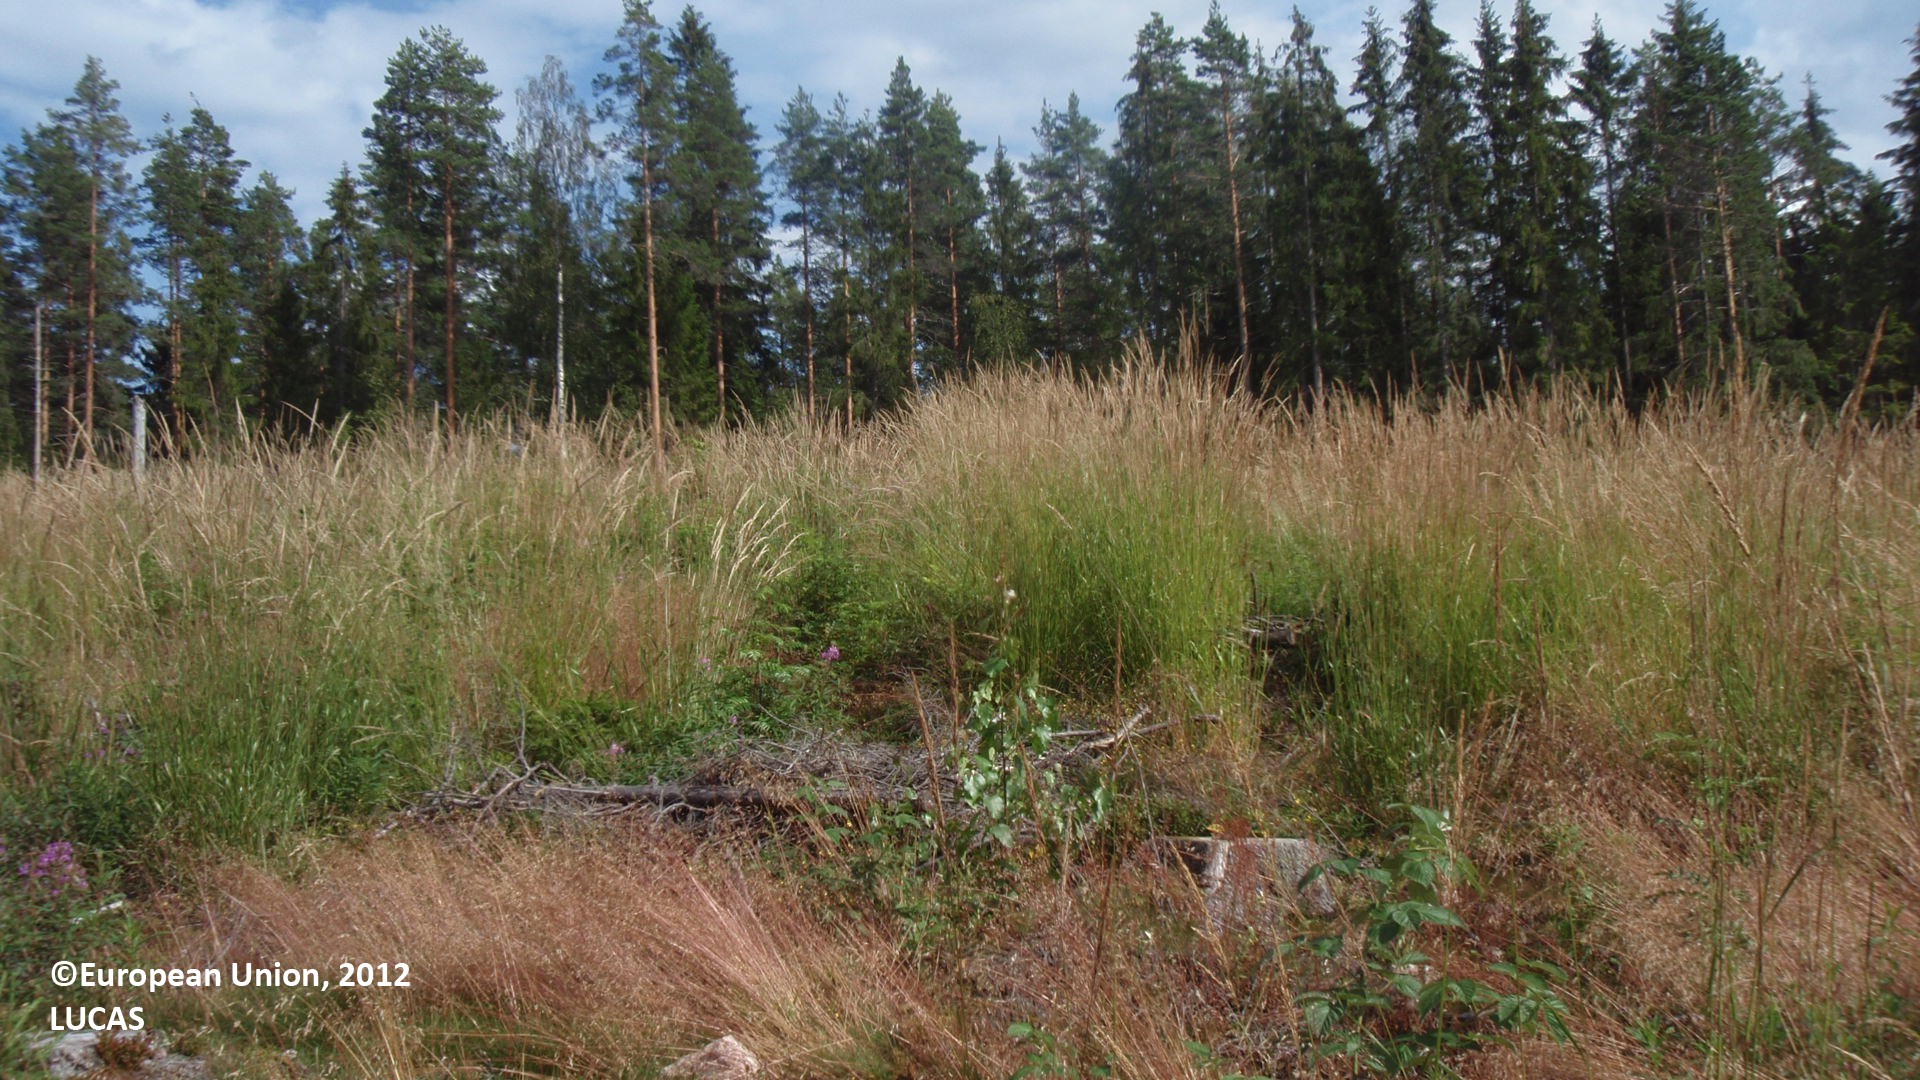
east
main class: Woodland
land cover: Spruce dominated mixed woodland
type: boreal forest
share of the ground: 10 - 25 %
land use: Forestry
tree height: < 5 m
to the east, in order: Spruce dominated mixed woodland; Pine dominated mixed woodland; Shrubland with sparse tree cover
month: July
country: FI
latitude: 61.4723
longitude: 28.7474
